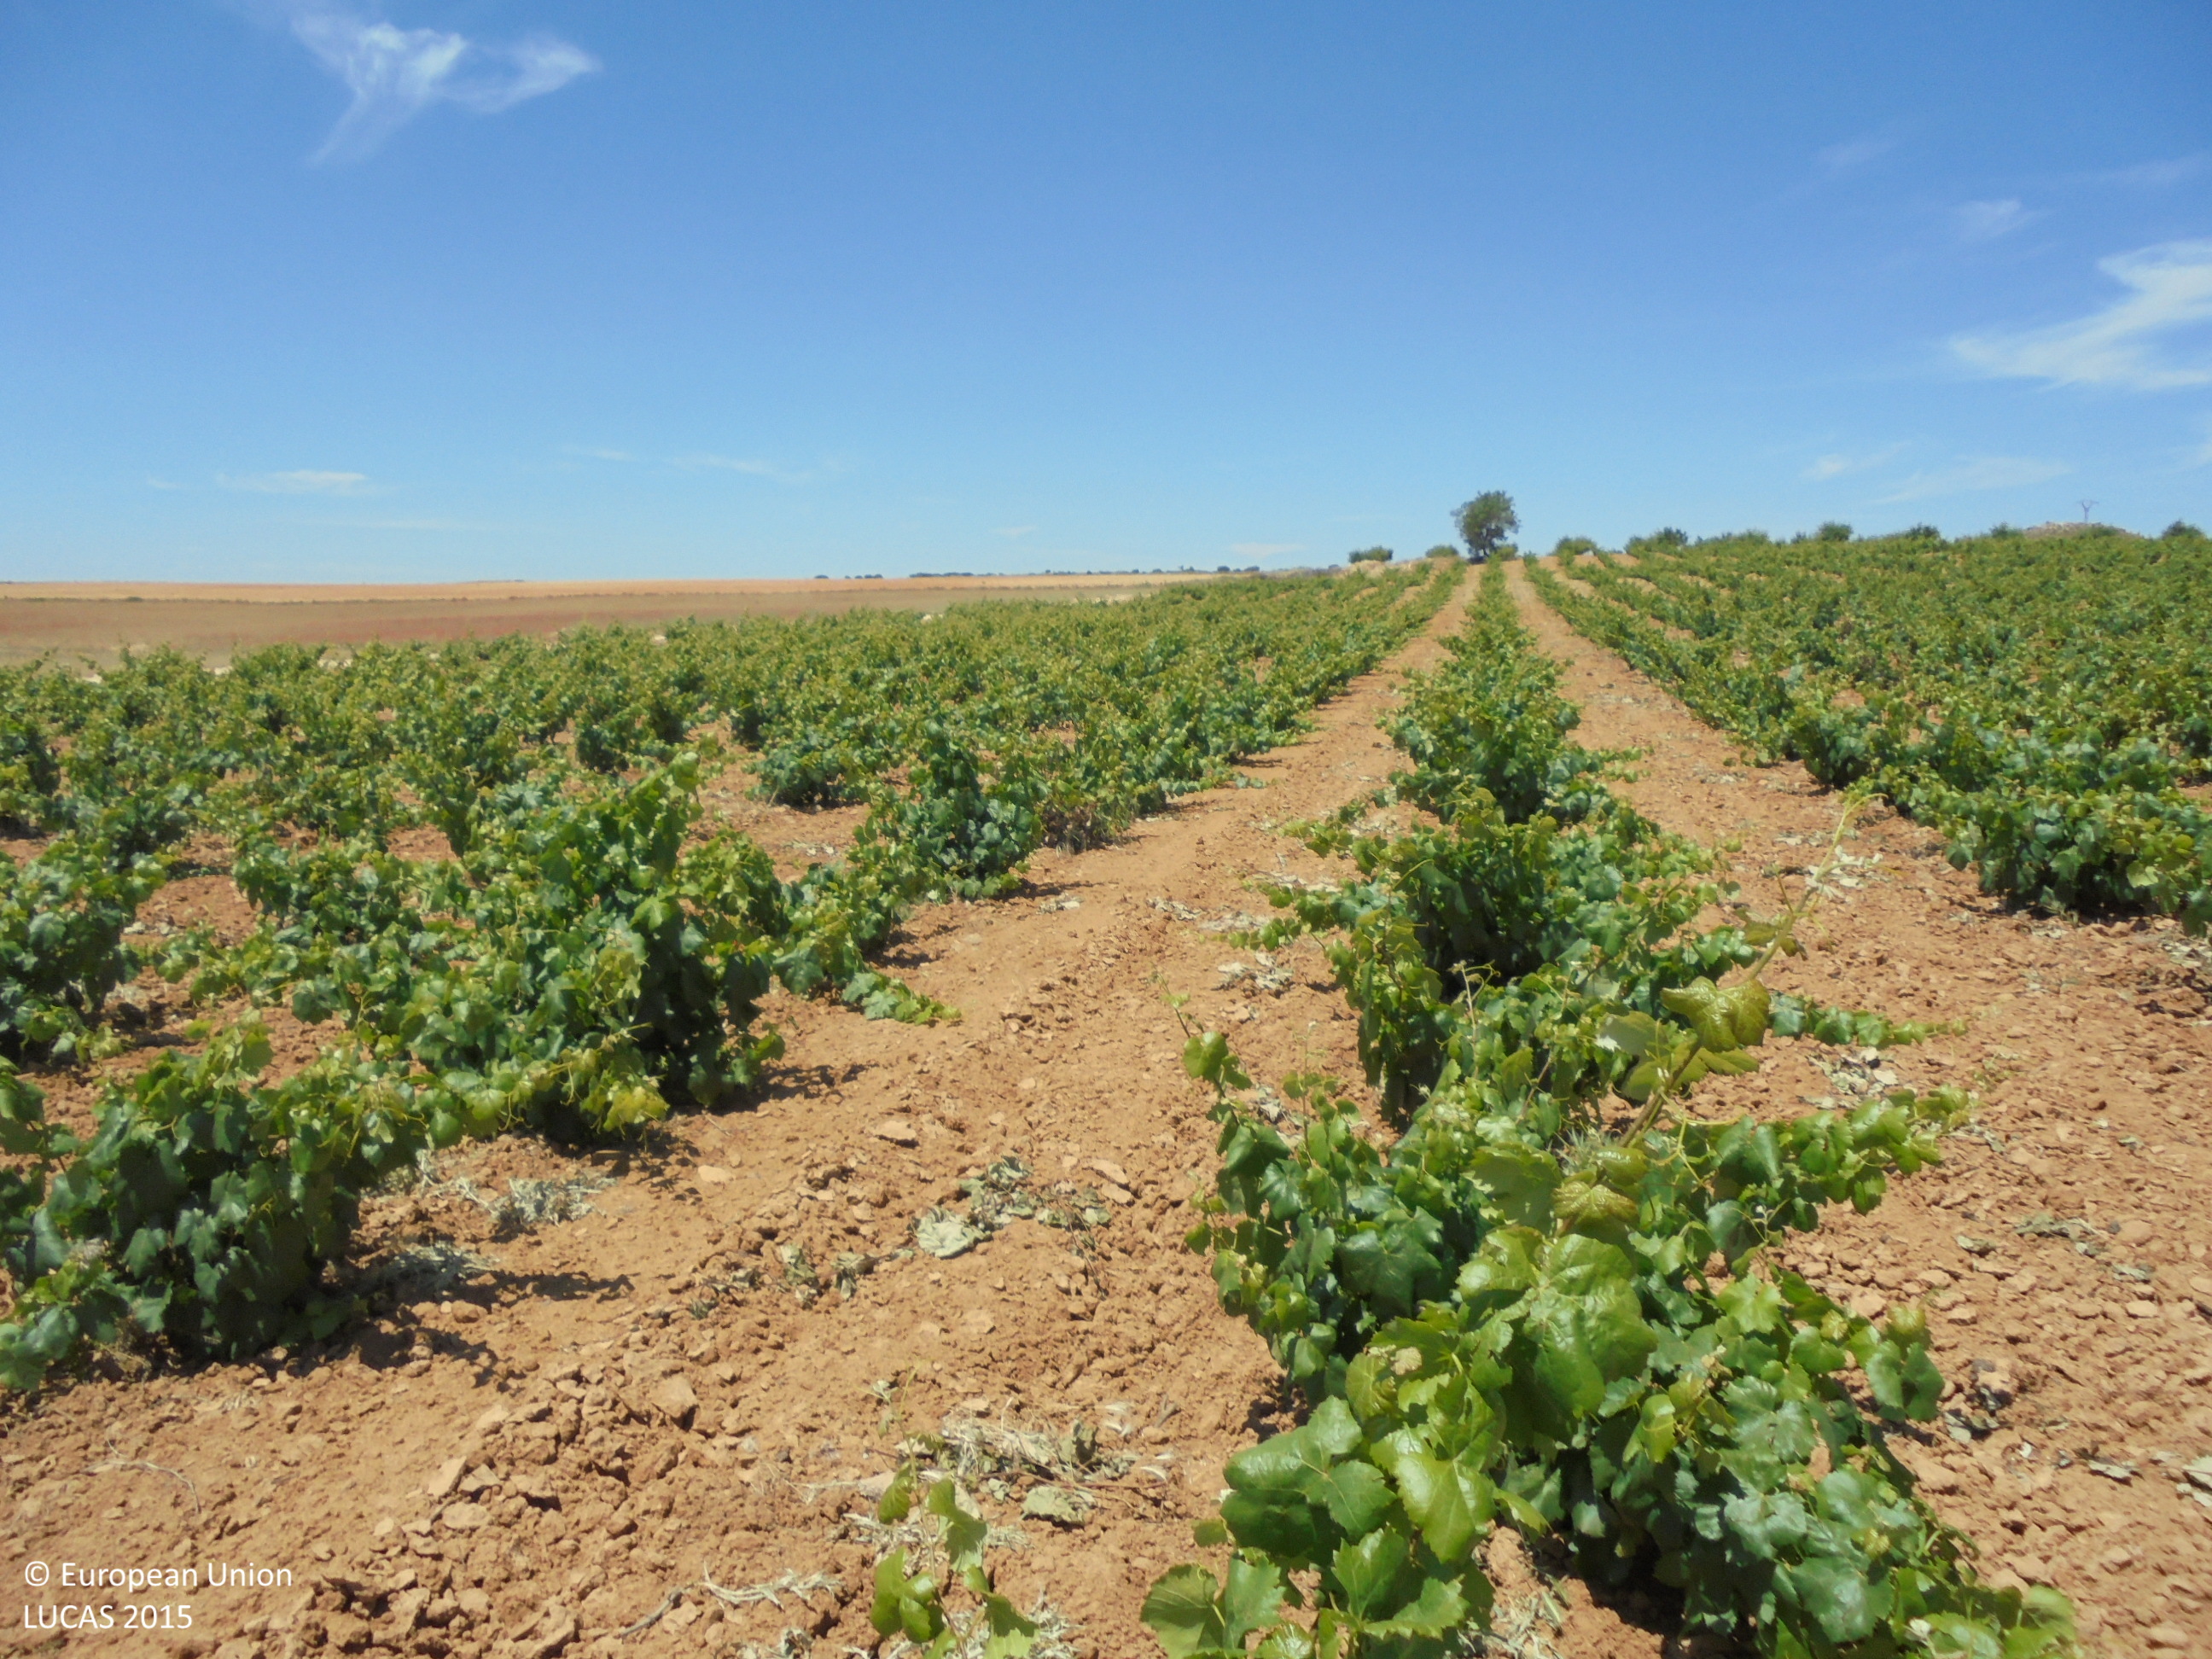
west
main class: Cropland
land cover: Vineyards
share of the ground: 25 - 50 %
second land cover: Other bare soil
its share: > 75 %
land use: Agriculture (excluding fallow land and kitchen gardens)
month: June
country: ES
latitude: 38.8309
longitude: -1.5734
